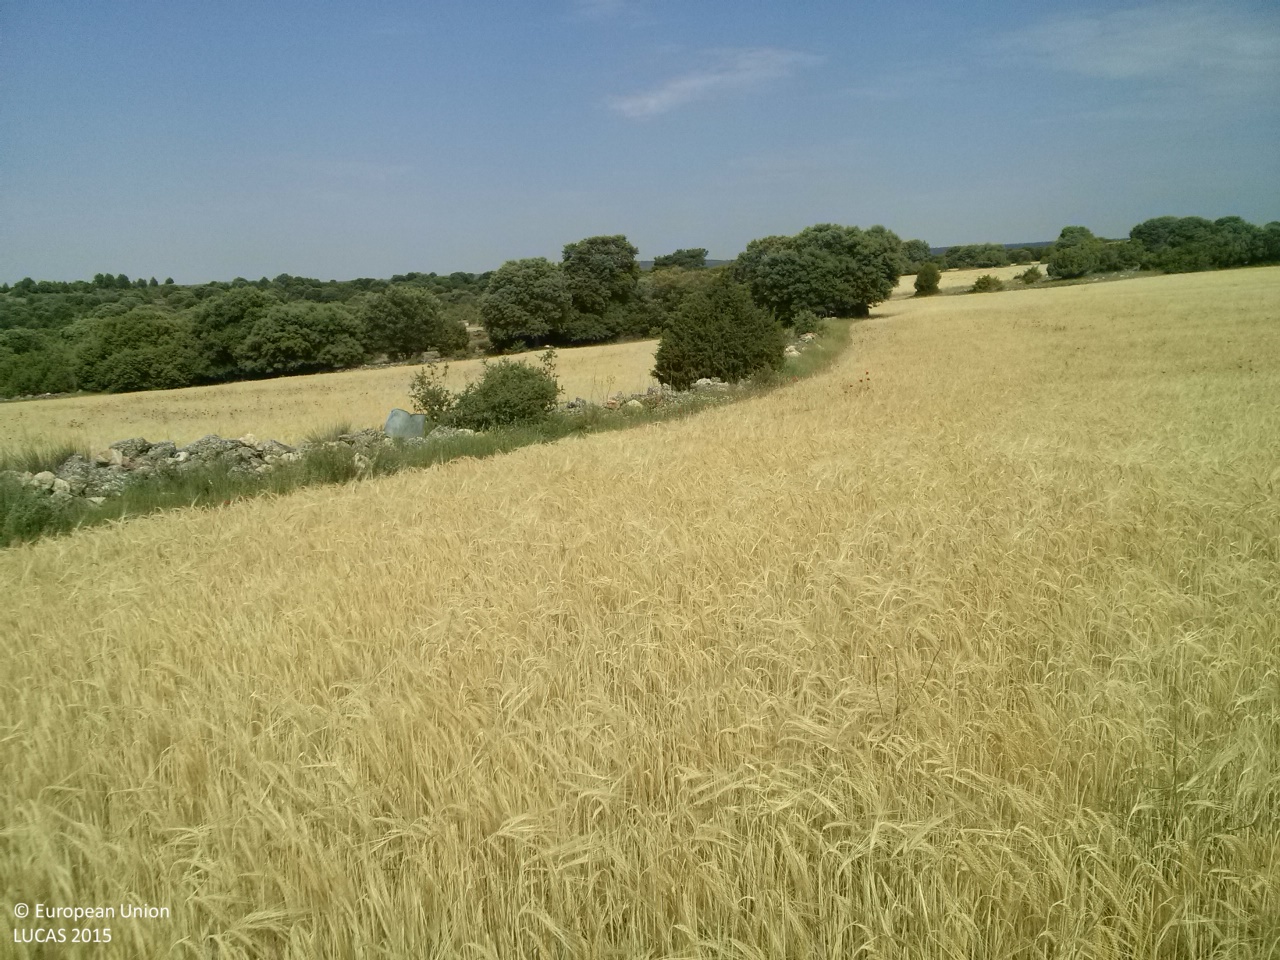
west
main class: Cropland
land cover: Barley
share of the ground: > 75 %
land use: Agriculture (excluding fallow land and kitchen gardens)
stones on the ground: 25 - 50 %
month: June
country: ES
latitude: 39.9583
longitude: -1.9177
